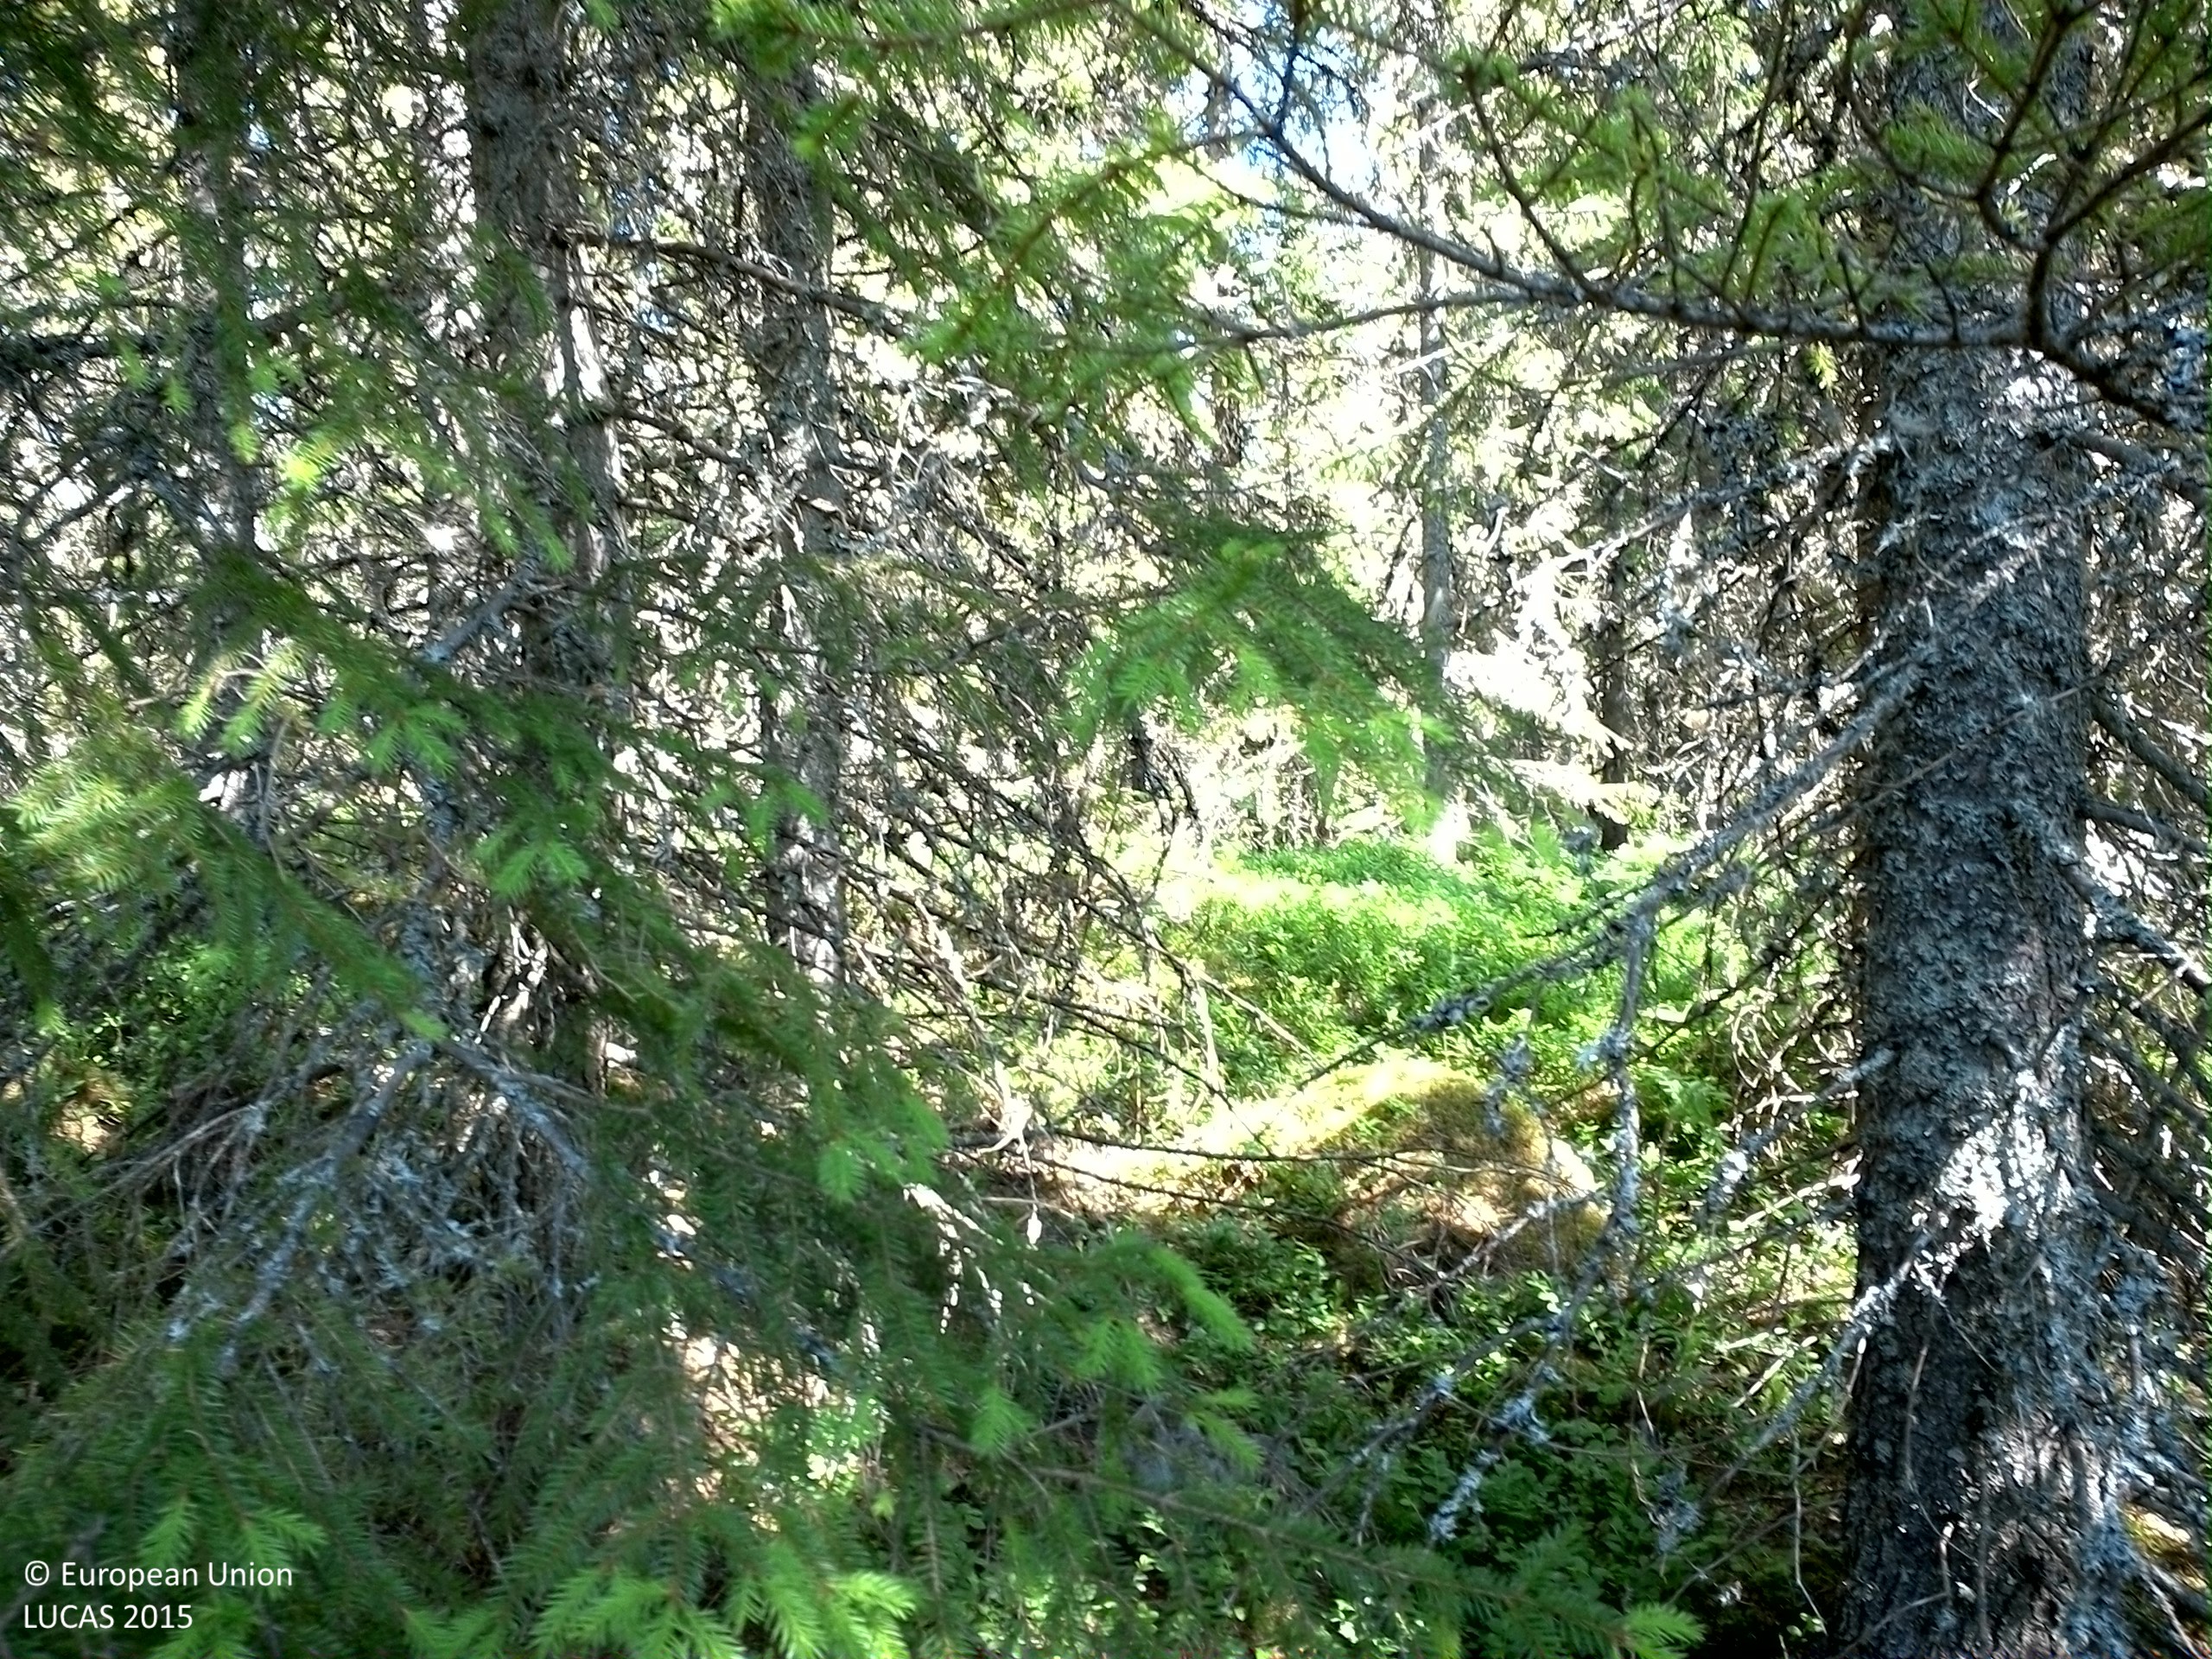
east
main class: Woodland
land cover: Spruce dominated coniferous woodland
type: boreal forest
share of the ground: 50 - 75 %
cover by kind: coniferous forest trees 70 %, shrubs 30 %
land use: Forestry
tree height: > 5 m
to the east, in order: Spruce dominated coniferous woodland; Spruce dominated mixed woodland; Pine dominated mixed woodland; Ditches and canals; Spruce dominated mixed woodland; Pine dominated coniferous woodland; Spruce dominated coniferous woodland
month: June
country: SE
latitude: 62.8325
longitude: 17.6936
